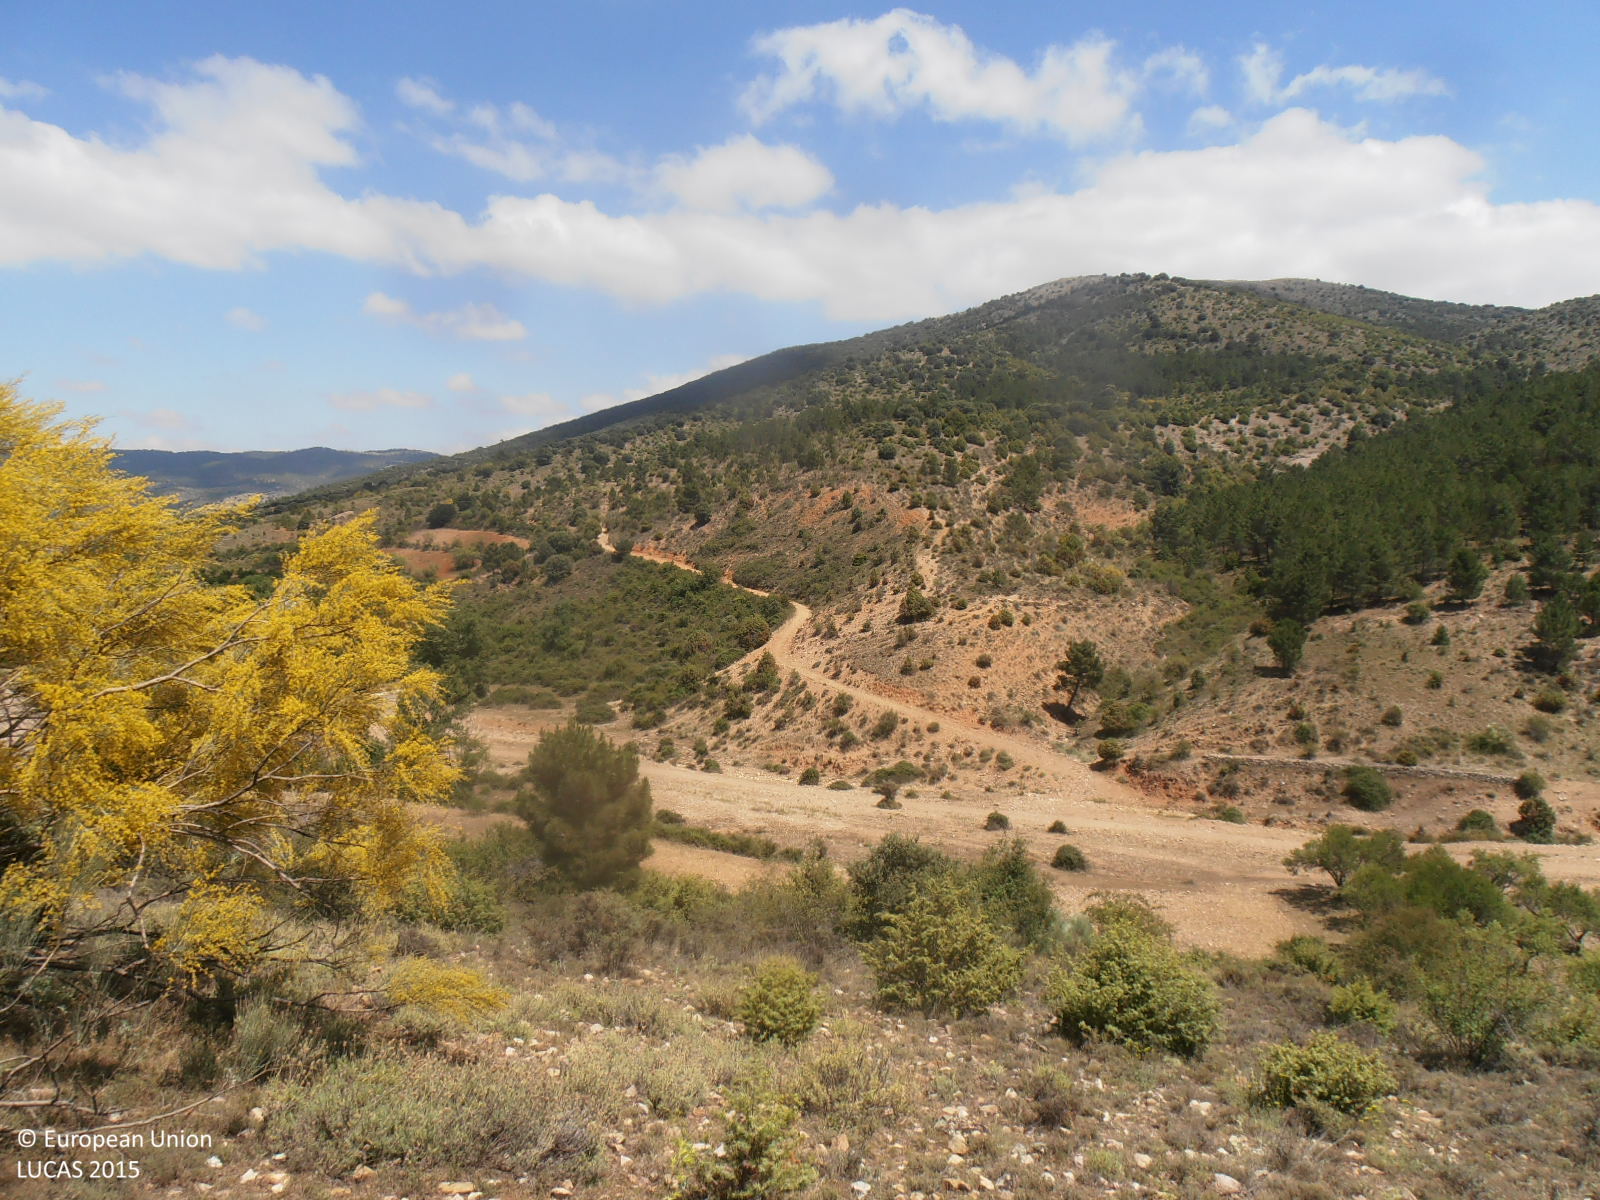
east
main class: Shrubland
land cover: Shrubland with sparse tree cover
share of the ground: 50 - 75 %
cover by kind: shrubs 60 %, consolidated bare surface 20 %, herbaceous plants 15 %, coniferous forest trees 5 %
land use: Semi-natural and natural areas not in use
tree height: < 5 m
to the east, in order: Shrubland with sparse tree cover; Shrubland without tree cover; Paved roads, cycling and walking lanes; Shrubland without tree cover; Spontaneously vegetated surfaces; Grassland without tree/shrub cover; Tracks; Shrubland without tree cover; Shrubland with sparse tree cover
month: June
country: ES
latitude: 41.2791
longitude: -1.4003
